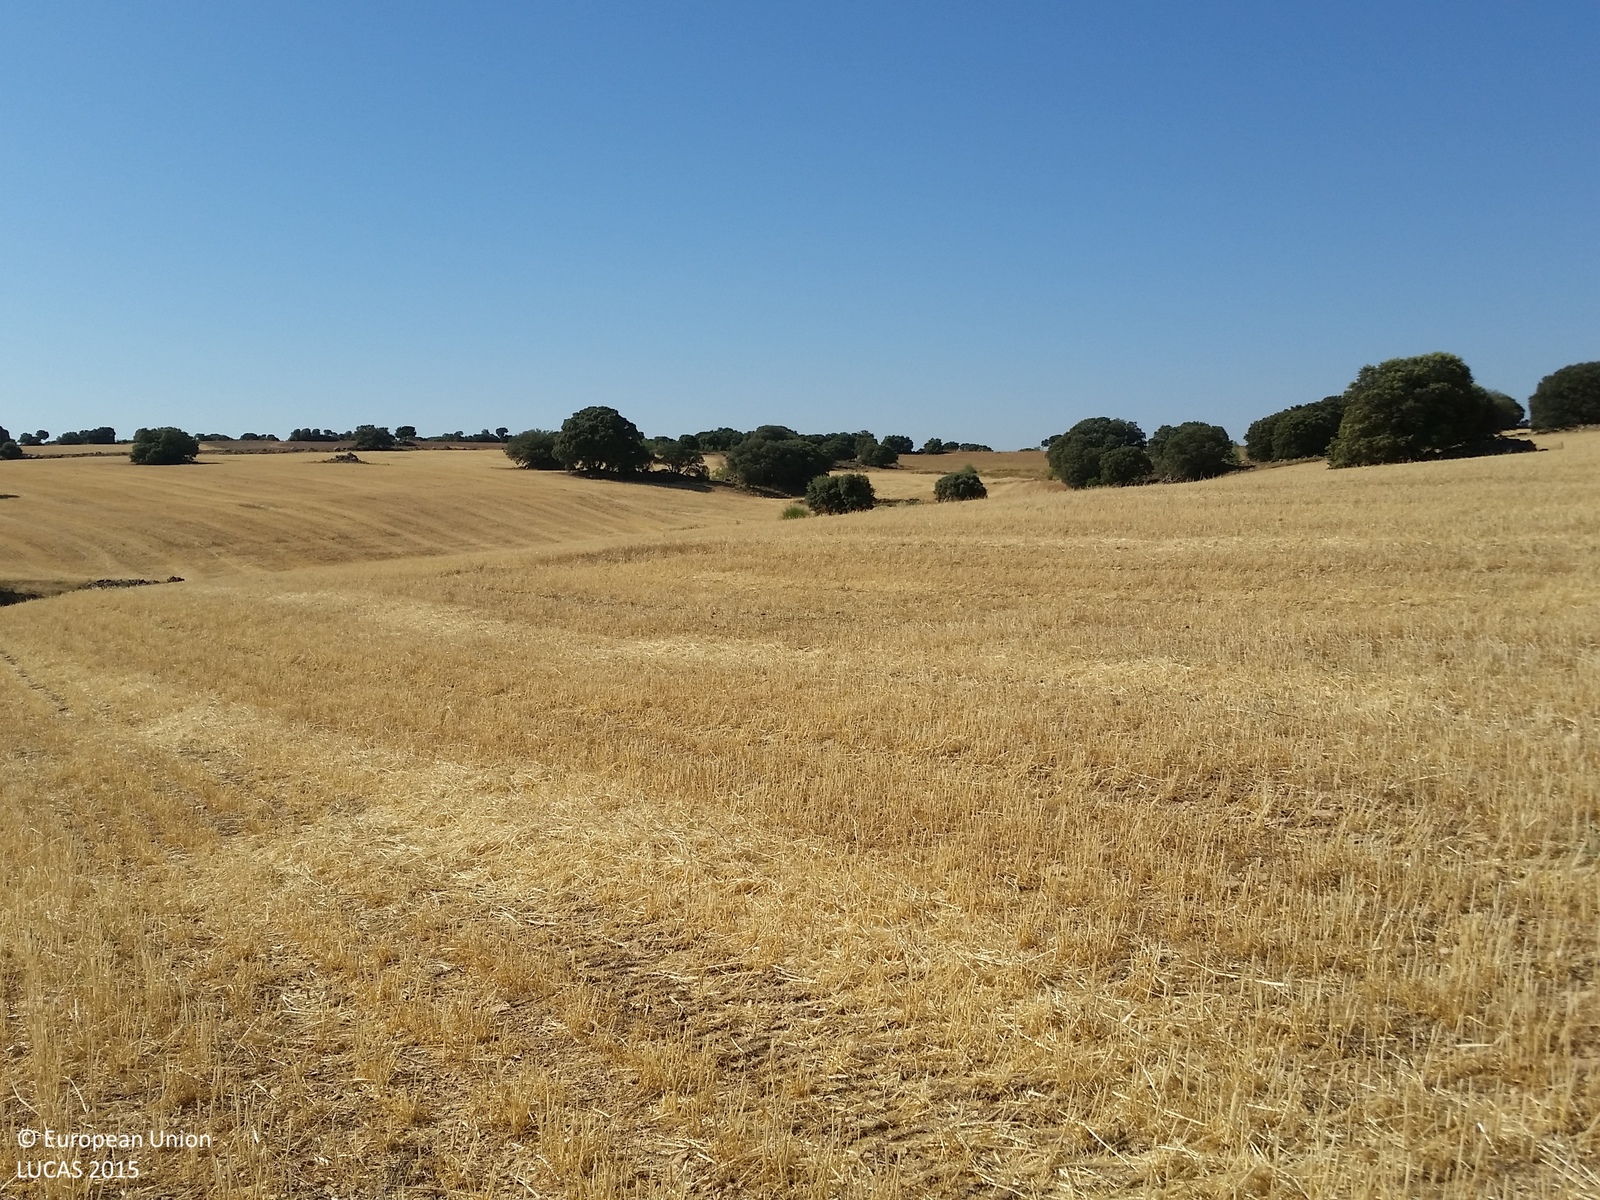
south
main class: Cropland
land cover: Barley
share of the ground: < 10 %
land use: Agriculture (excluding fallow land and kitchen gardens)
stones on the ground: 10 - 25 %
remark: Harvested field
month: July
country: ES
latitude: 39.0027
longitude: -2.5346
